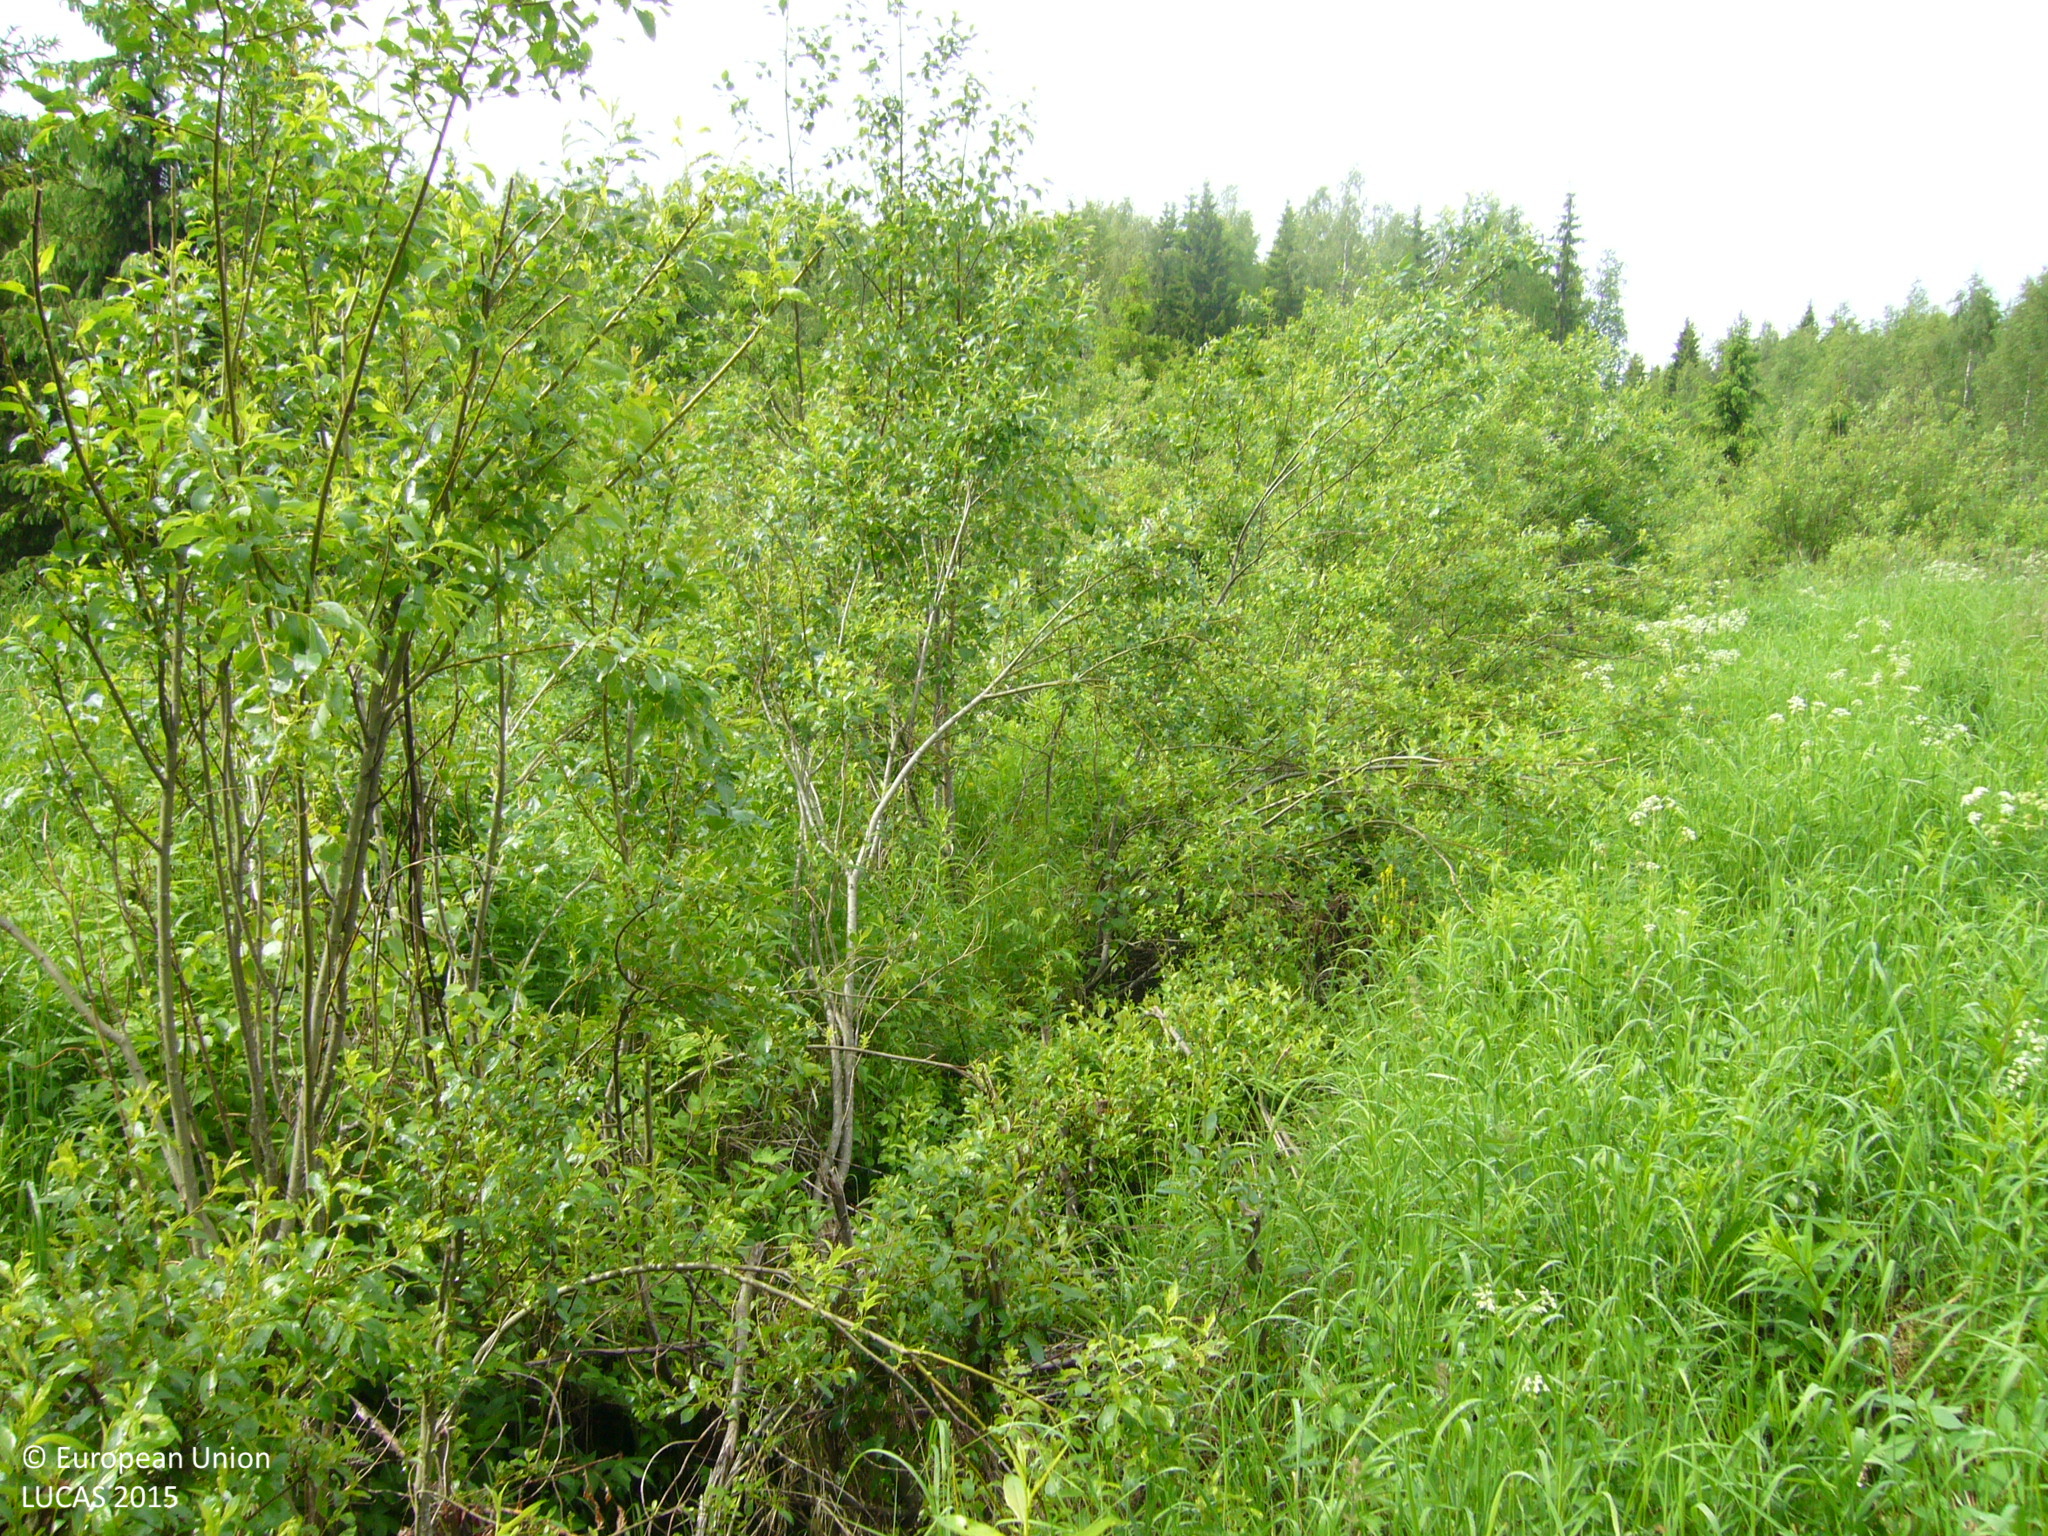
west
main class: Woodland
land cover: Spruce dominated mixed woodland
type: boreal forest
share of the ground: 50 - 75 %
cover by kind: coniferous forest trees 40 %, herbaceous plants 35 %, broadleaved forest trees 25 %
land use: Forestry
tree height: > 5 m
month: June
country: FI
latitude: 63.7891
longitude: 26.4581
